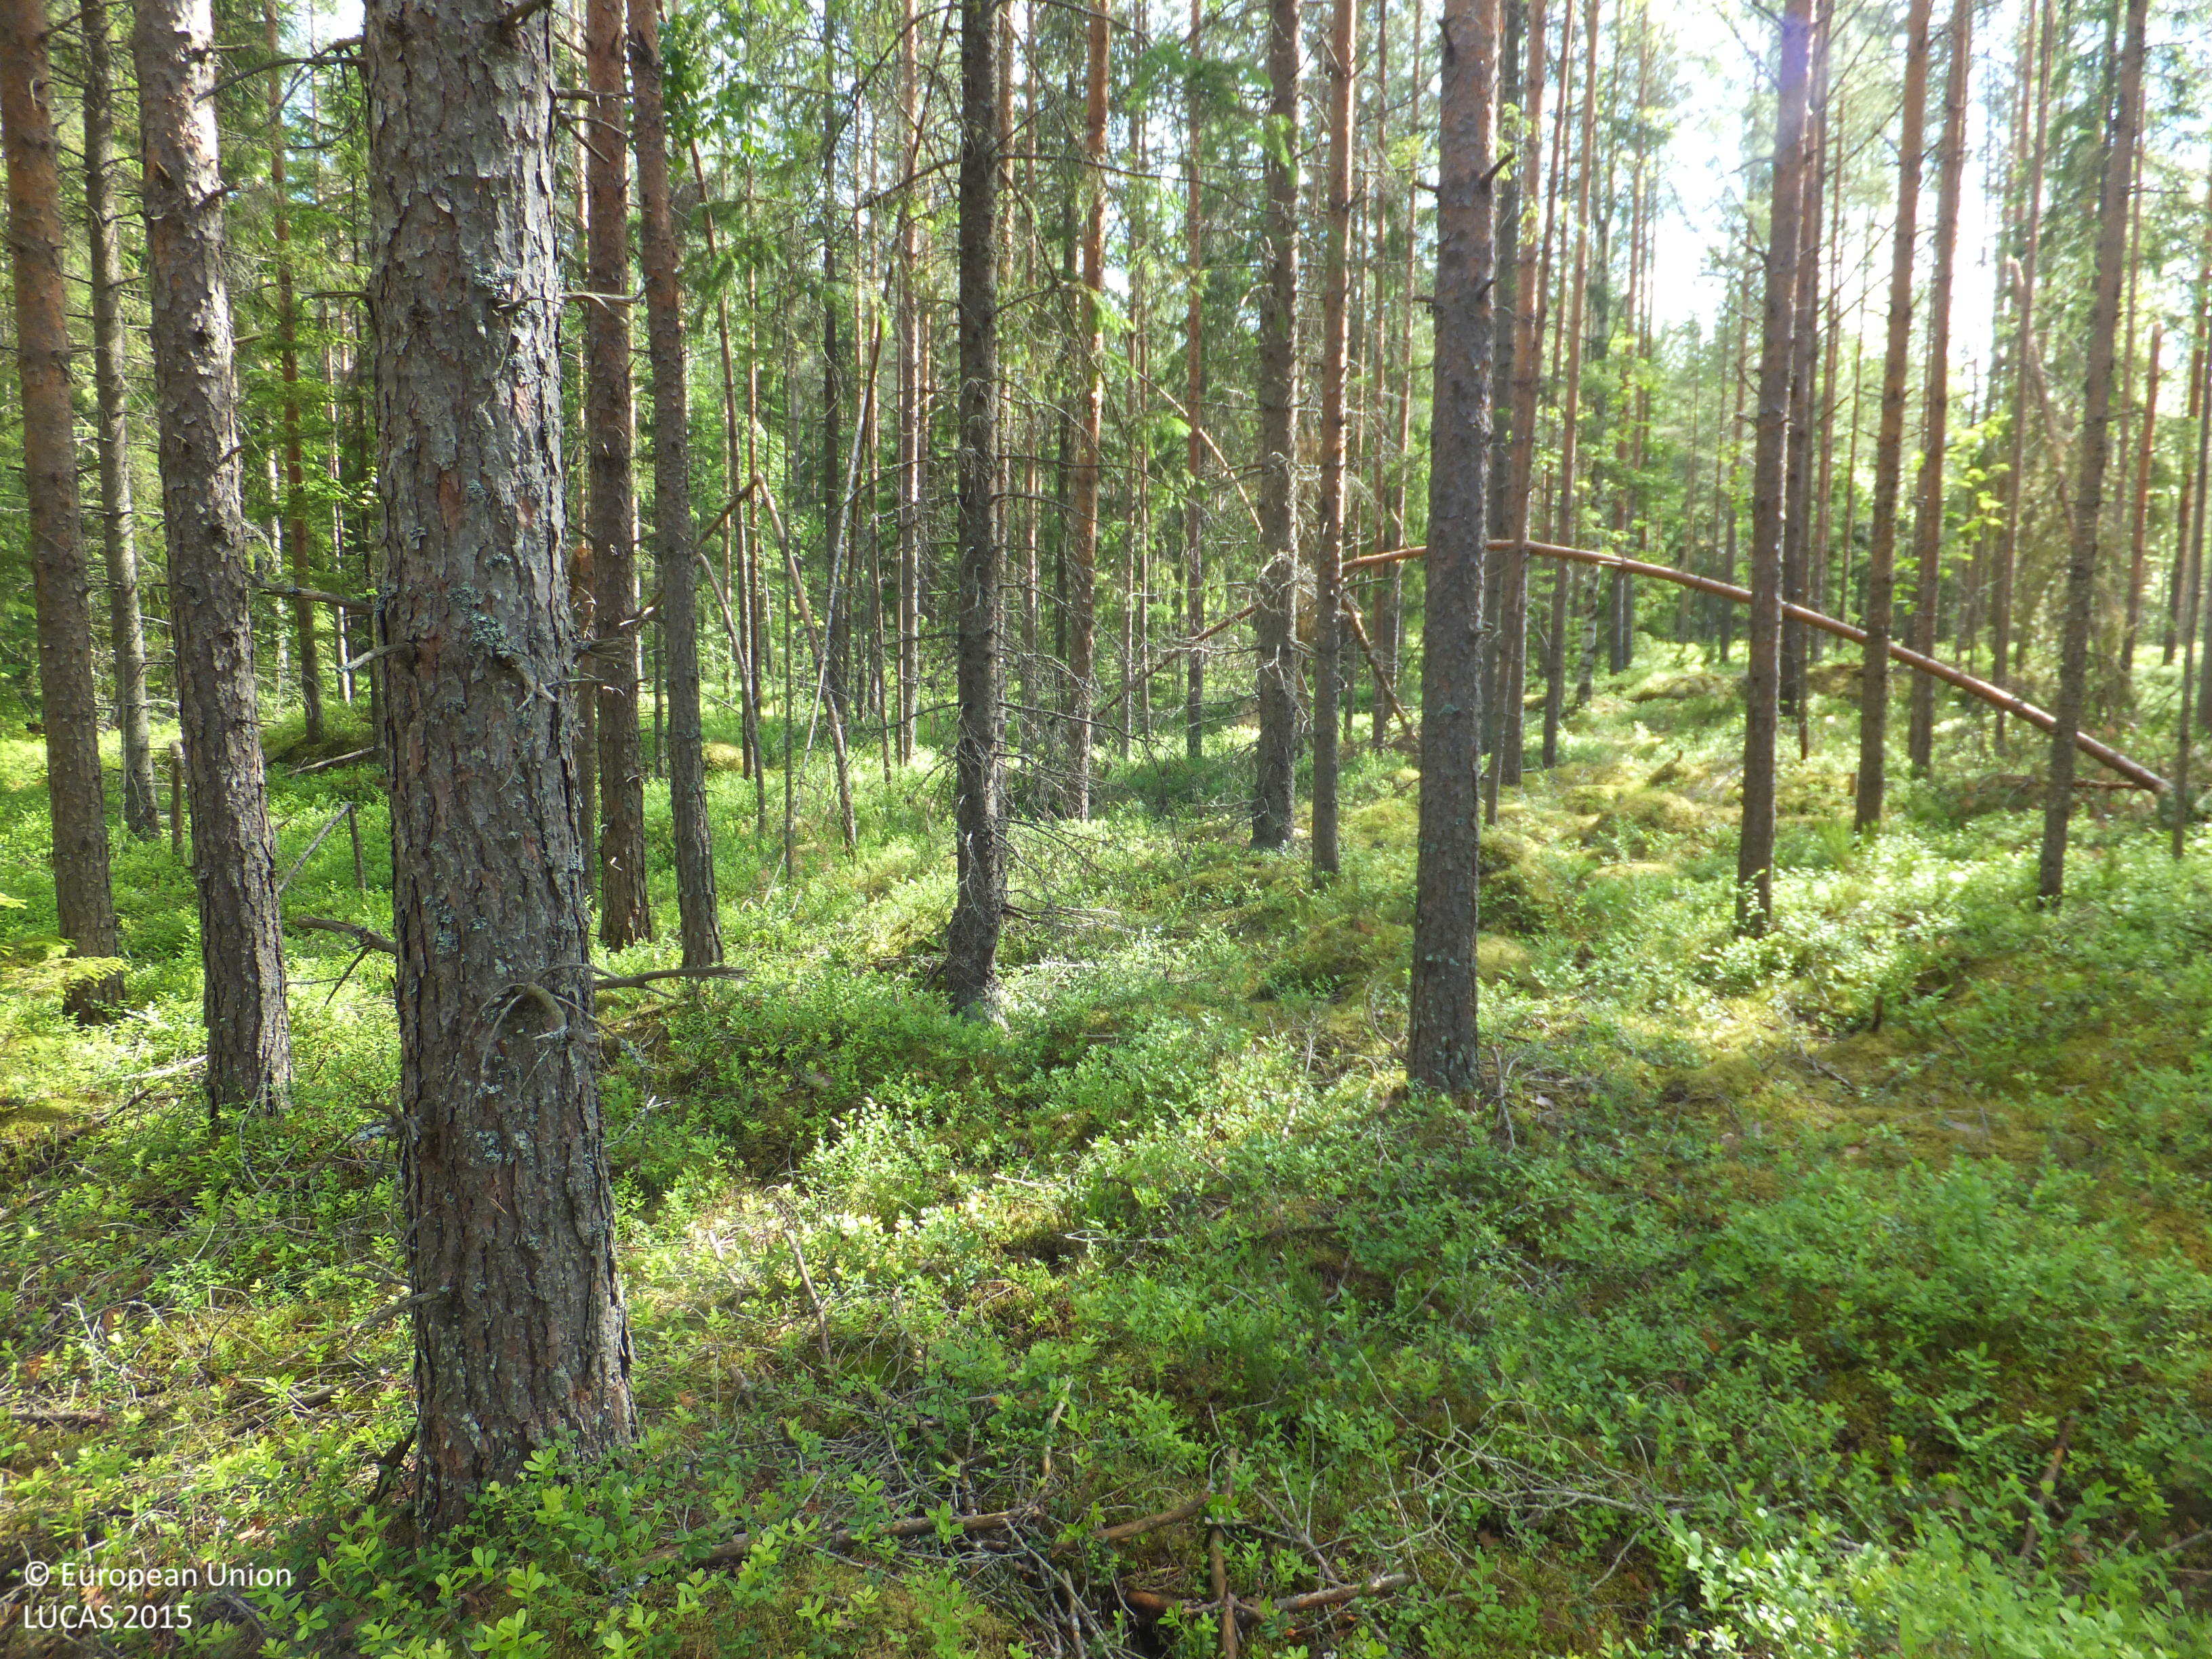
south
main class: Woodland
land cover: Pine dominated coniferous woodland
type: boreal forest
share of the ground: > 75 %
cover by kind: coniferous forest trees 75 %, shrubs 10 %, lichens and mosses 10 %, broadleaved forest trees 5 %
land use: Forestry
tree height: > 5 m
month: July
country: FI
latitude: 63.0791
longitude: 23.9516
